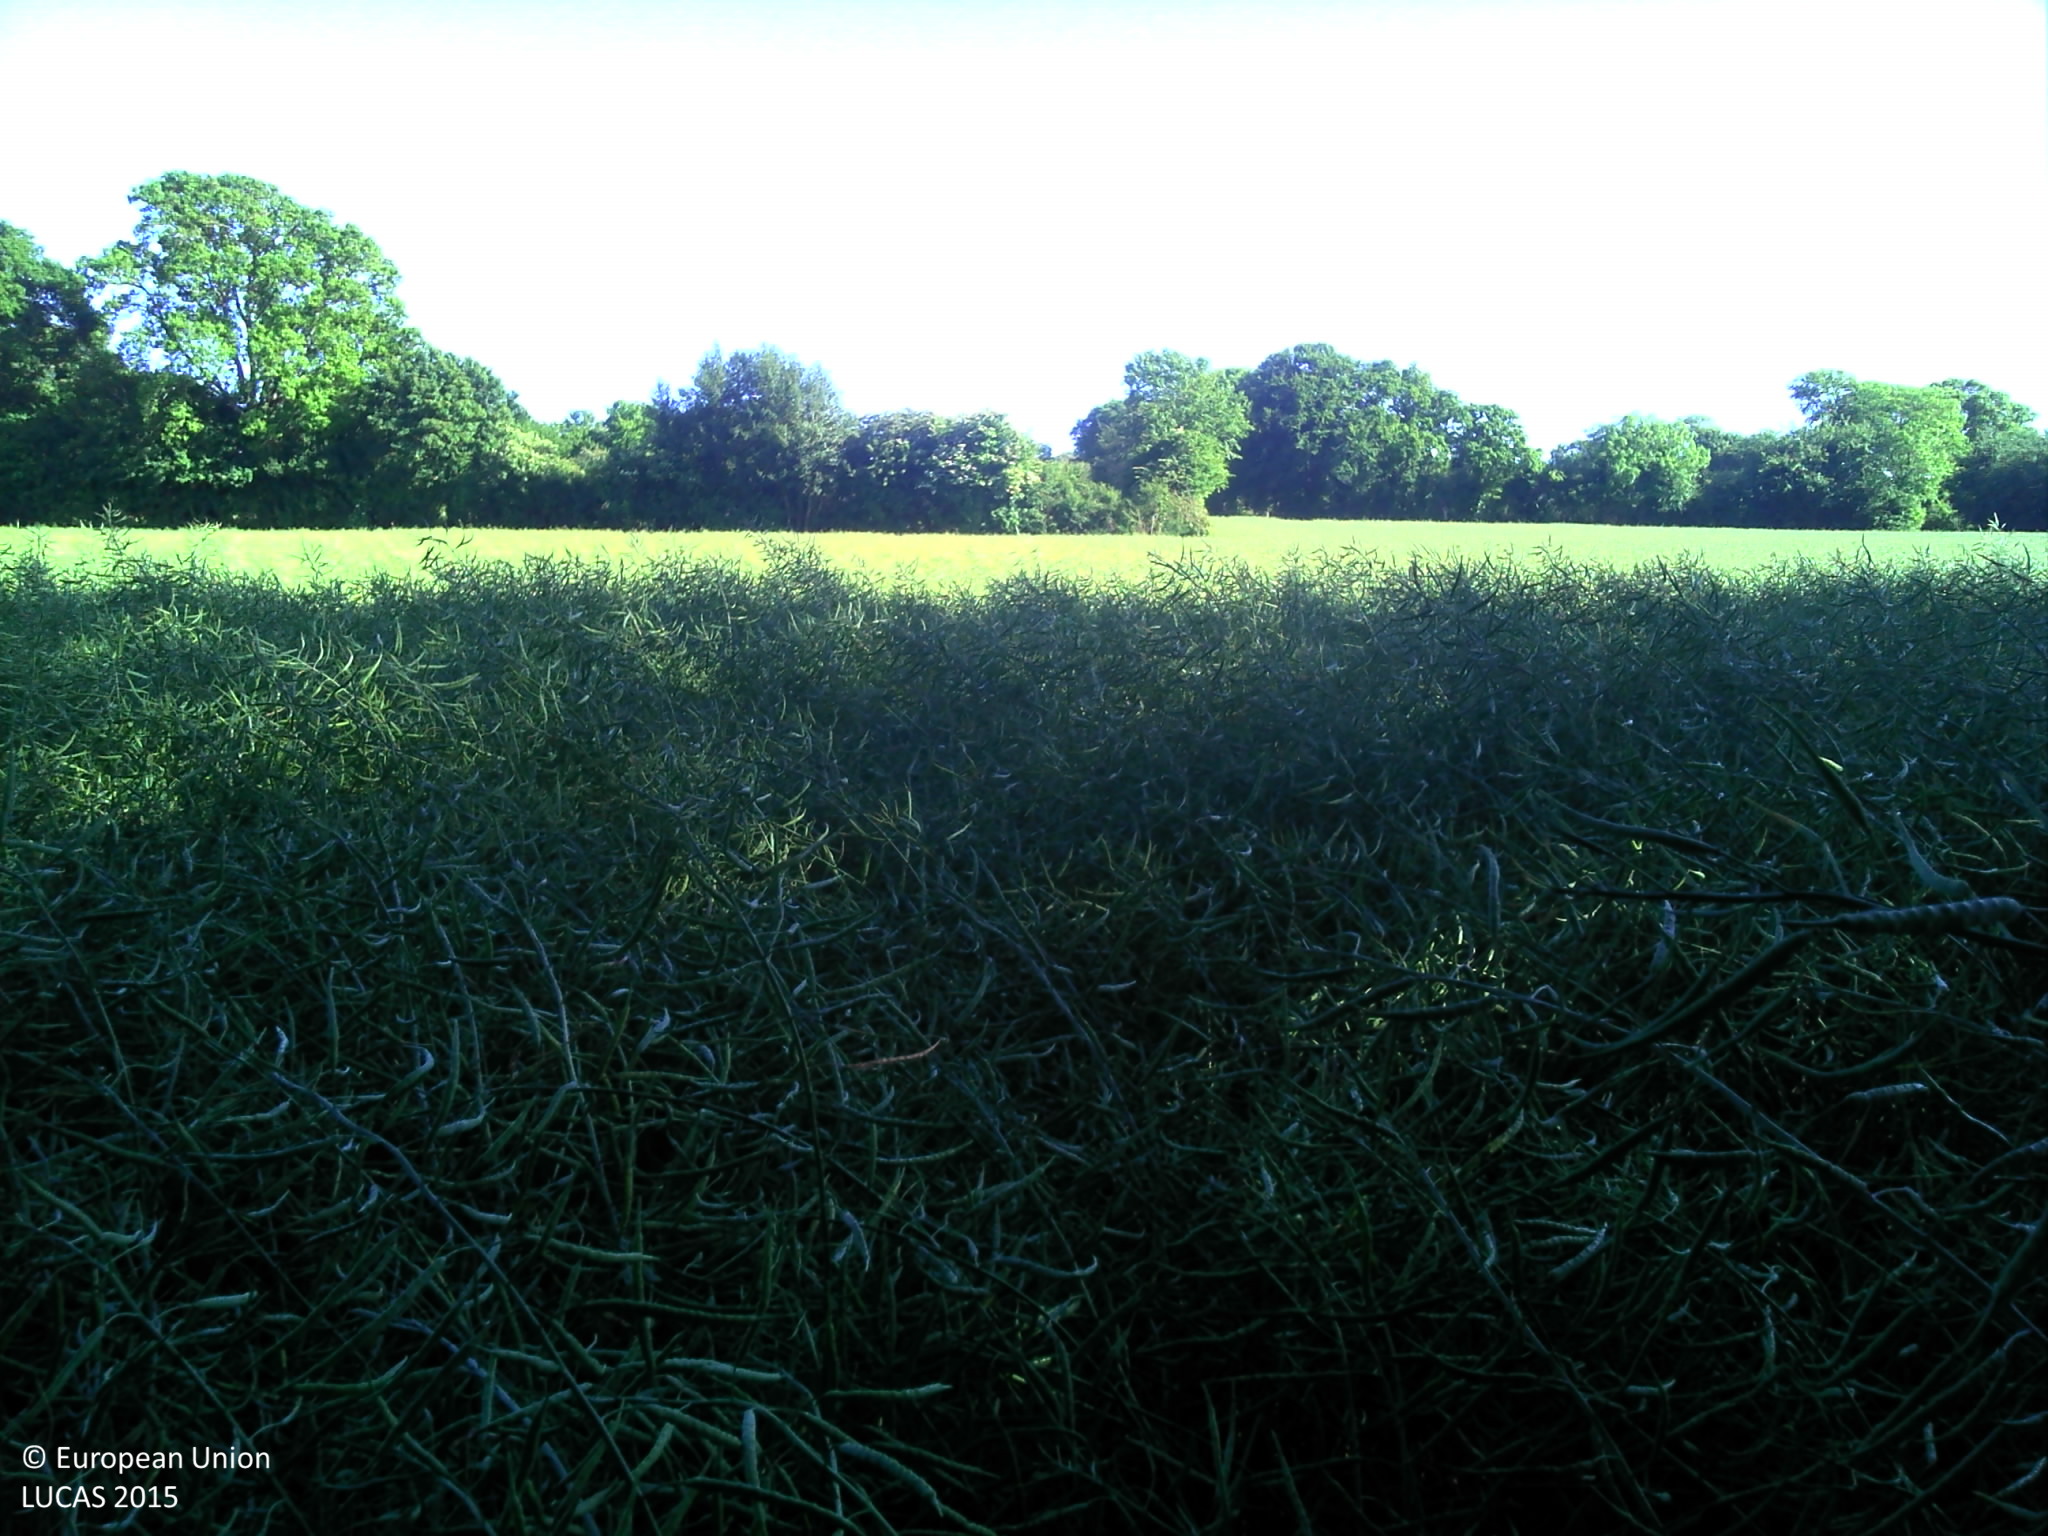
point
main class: Cropland
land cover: Rape and turnip rape
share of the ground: > 75 %
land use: Agriculture (excluding fallow land and kitchen gardens)
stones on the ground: < 10 %
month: June
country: FR
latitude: 49.4988
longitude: -1.7760
